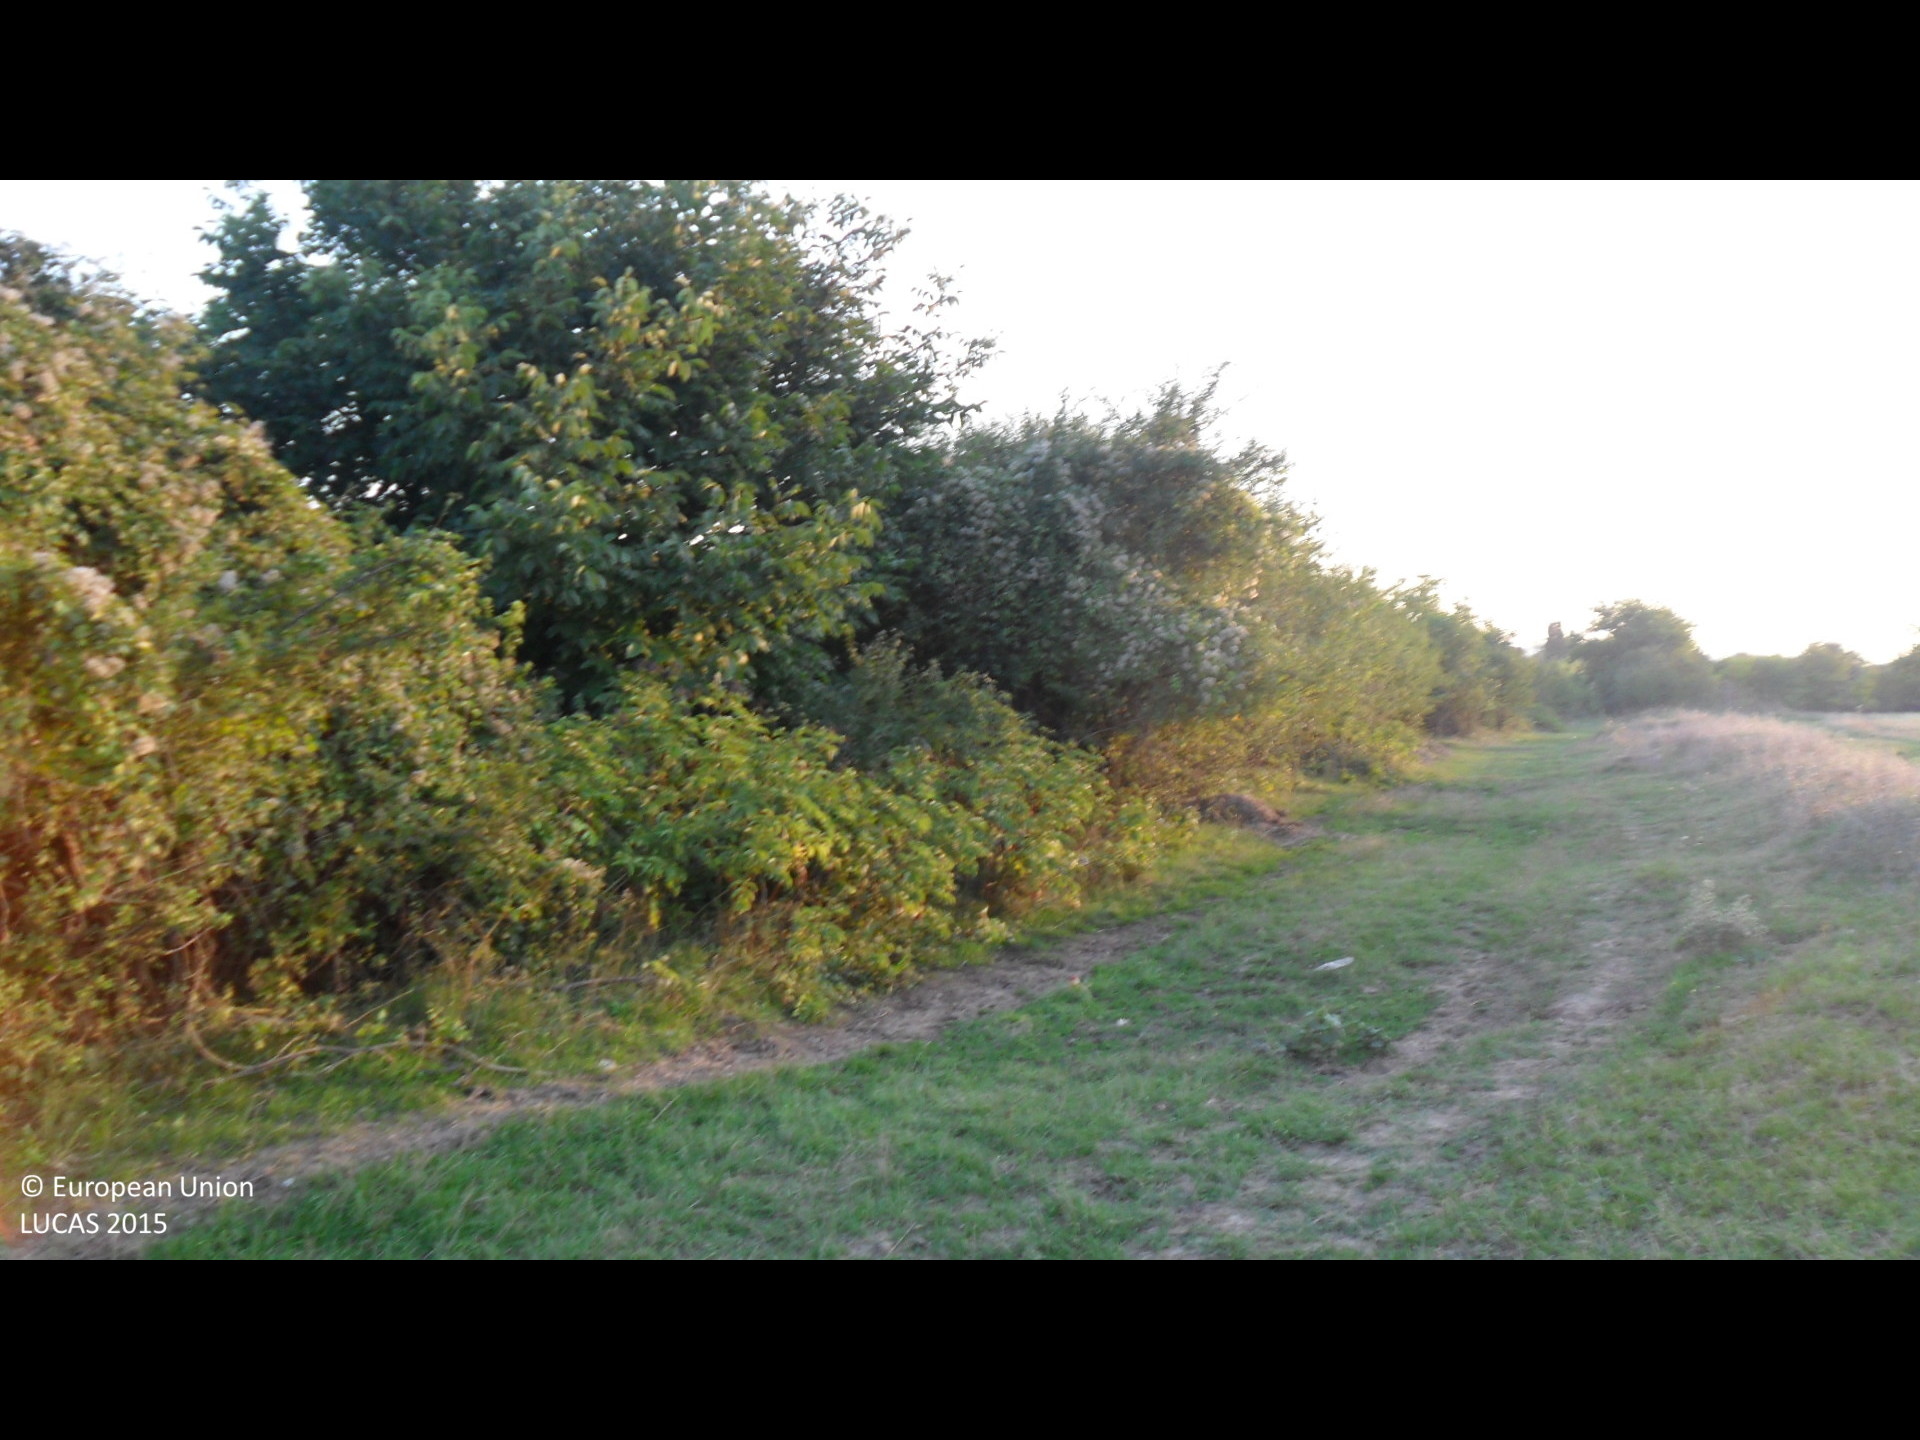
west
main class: Grassland
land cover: Grassland with sparse tree/shrub cover
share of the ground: > 75 %
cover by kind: herbaceous plants 90 %, broadleaved forest trees 5 %, shrubs 5 %
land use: Abandoned areas
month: August
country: BG
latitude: 43.2422
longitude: 26.5939
